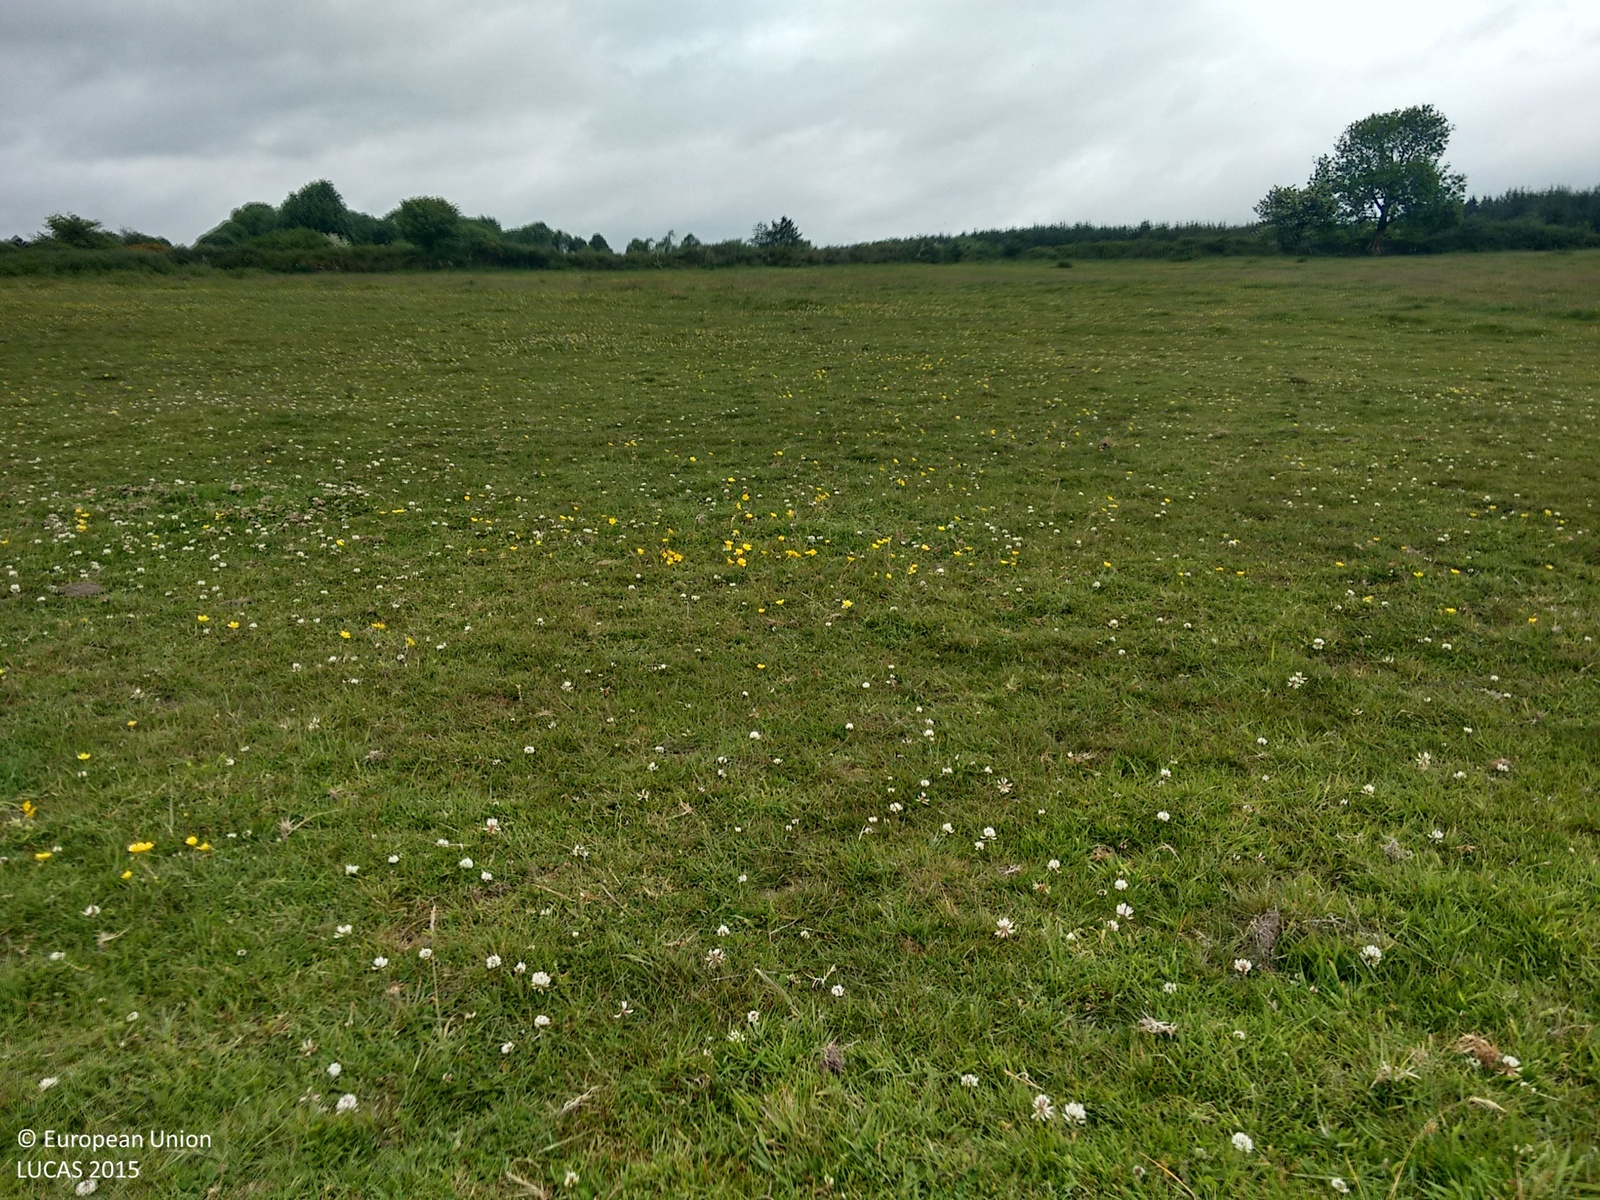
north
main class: Grassland
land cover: Grassland without tree/shrub cover
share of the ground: > 75 %
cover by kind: herbaceous plants 100 %
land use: Agriculture (excluding fallow land and kitchen gardens)
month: June
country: IE
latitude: 52.0133
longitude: -8.1462
